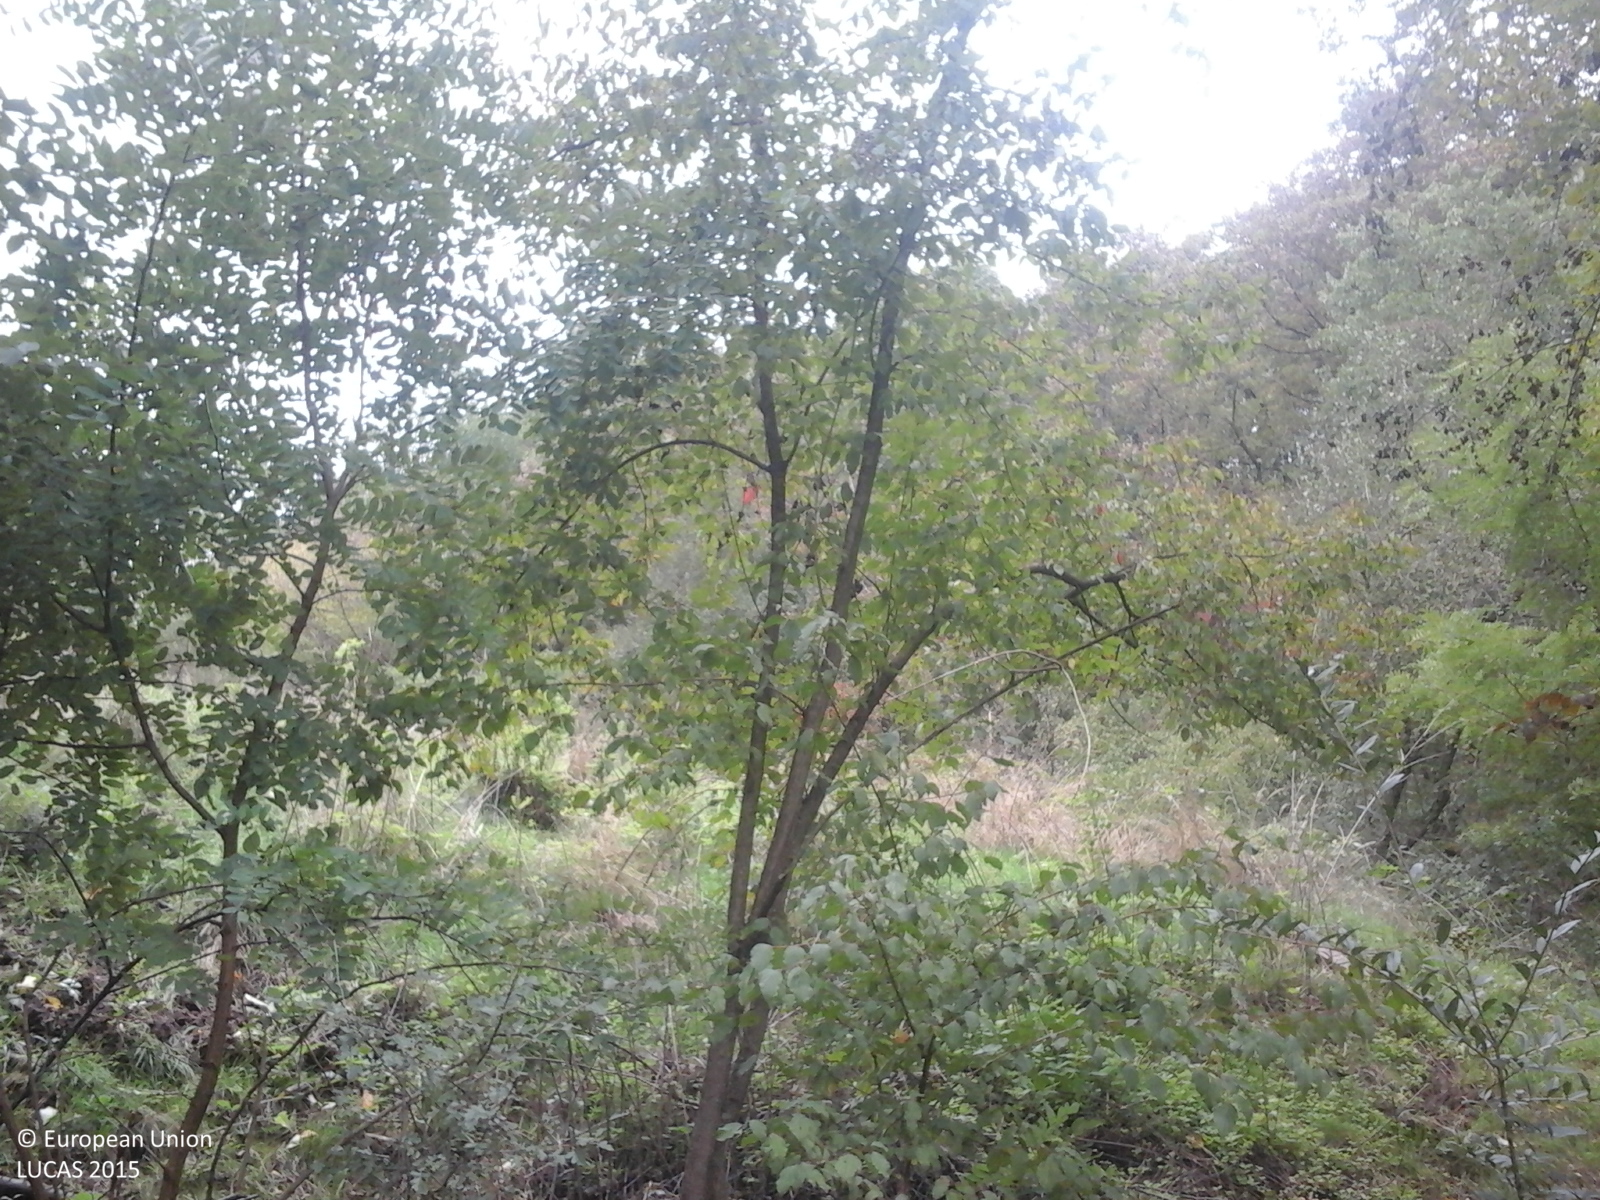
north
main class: Woodland
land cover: Broadleaved woodland
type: exotic forest
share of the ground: > 75 %
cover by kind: broadleaved forest trees 100 %
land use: Forestry
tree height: > 5 m
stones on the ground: < 10 %
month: September
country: RO
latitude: 45.8752
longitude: 23.0557
